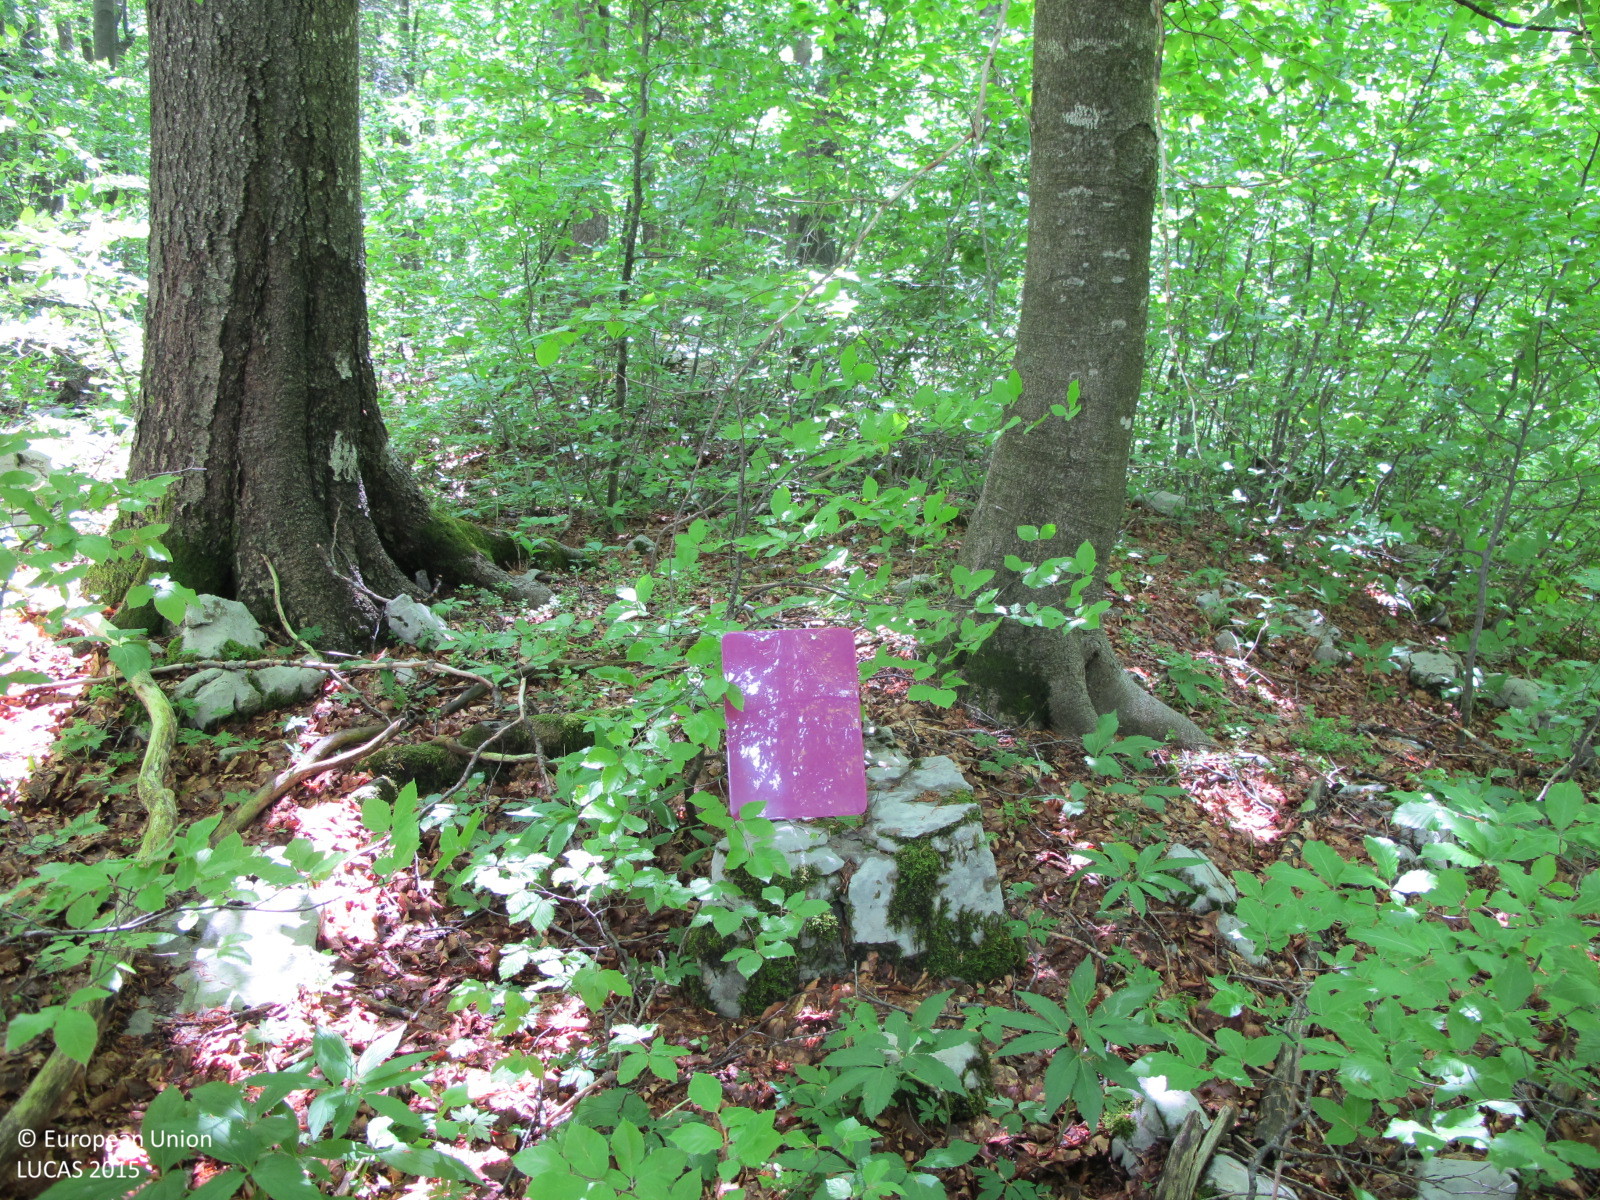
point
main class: Woodland
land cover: Broadleaved woodland
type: mountainous beech forest
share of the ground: > 75 %
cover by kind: broadleaved forest trees 90 %, coniferous forest trees 5 %, shrubs 5 %
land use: Forestry
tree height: > 5 m
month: May
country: HR
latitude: 45.4611
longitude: 14.5353
